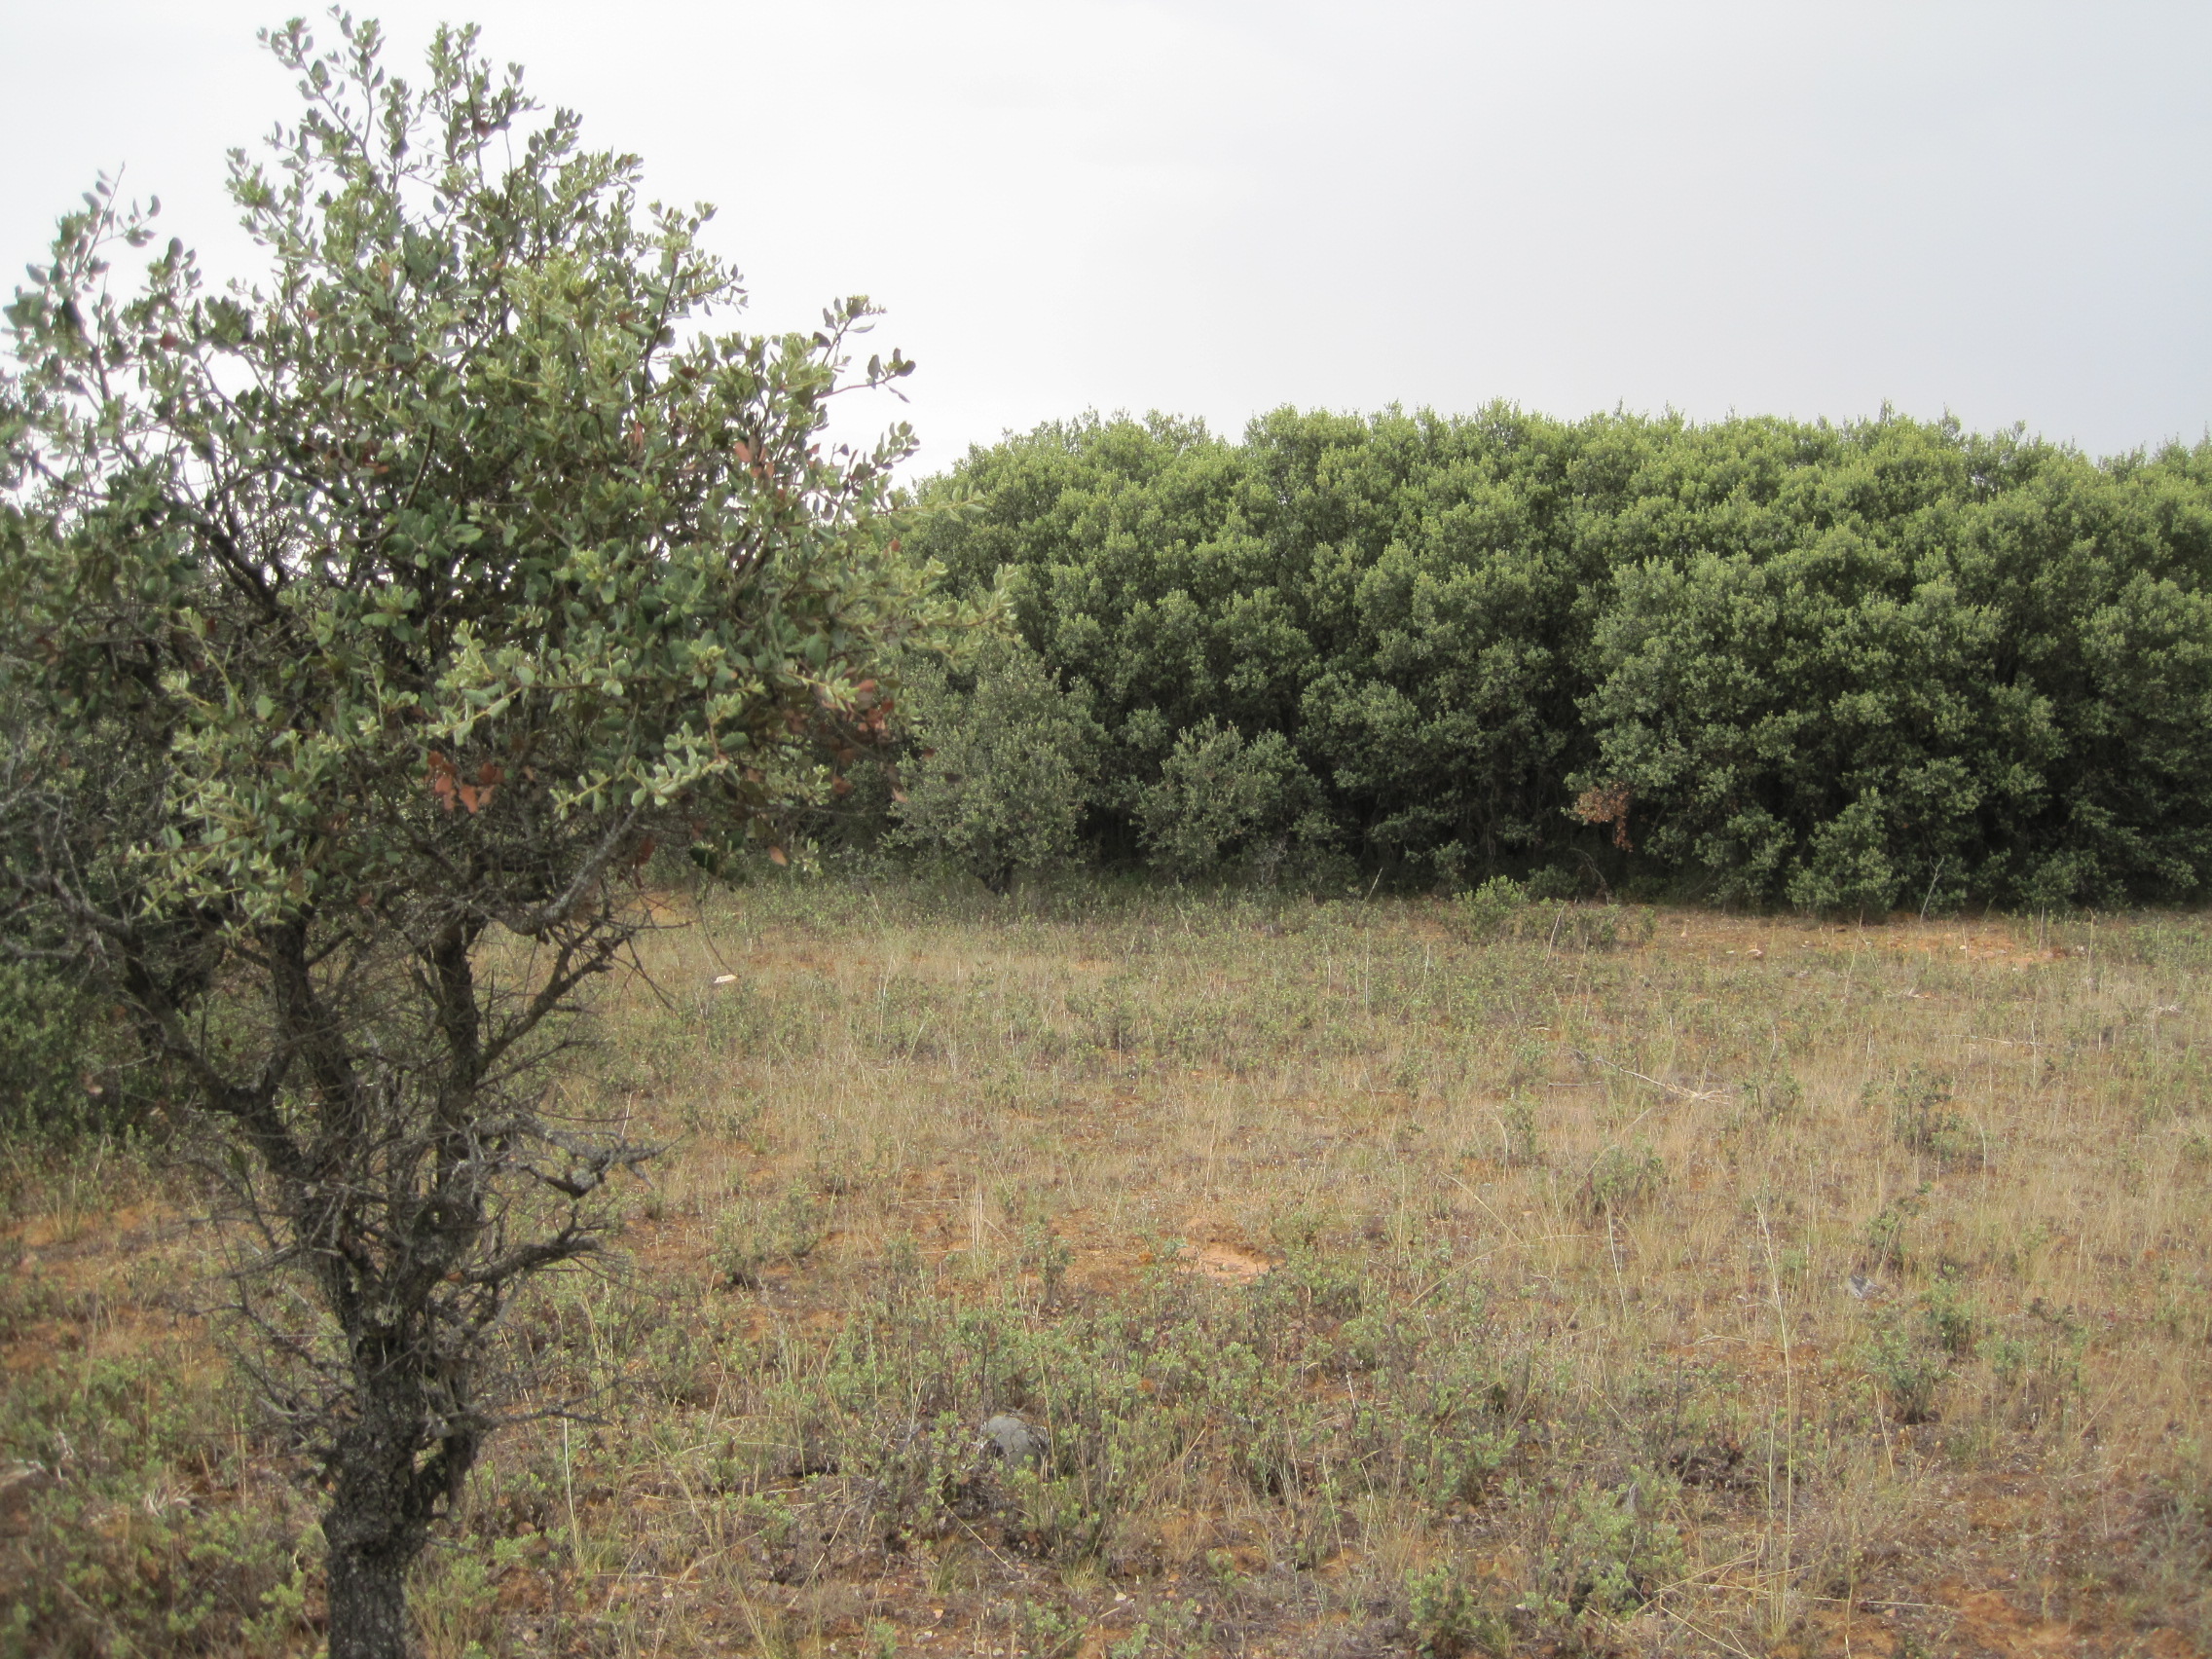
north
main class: Woodland
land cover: Broadleaved woodland
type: broadleaved evergreen forest
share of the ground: 50 - 75 %
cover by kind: broadleaved forest trees 60 %, herbaceous plants 40 %
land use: Forestry
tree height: > 5 m
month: July
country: ES
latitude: 41.7729
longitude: -5.4465
